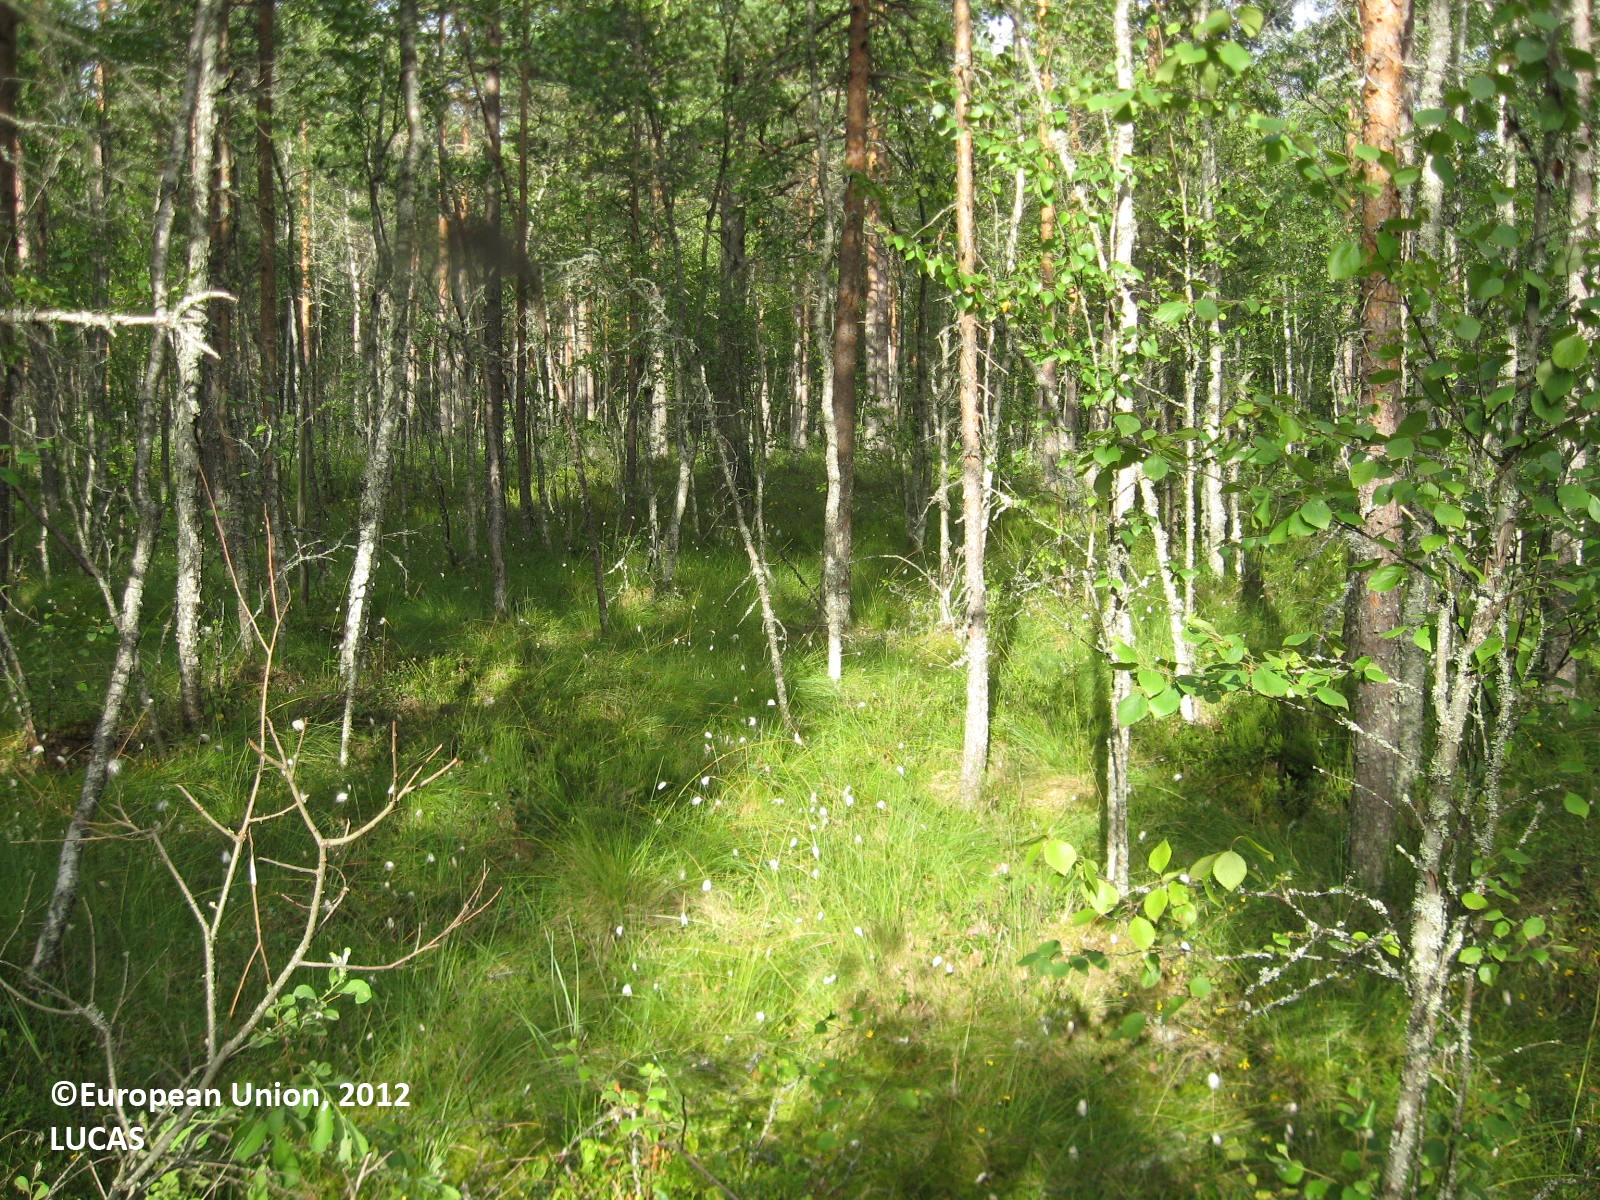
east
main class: Woodland
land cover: Pine dominated mixed woodland
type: boreal forest
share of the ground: > 75 %
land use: Forestry
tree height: > 5 m
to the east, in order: Pine dominated mixed woodland; Ditches and canals; Broadleaved woodland; Tracks; Pine dominated coniferous woodland; Ditches and canals; Pine dominated mixed woodland; Ditches and canals; Pine dominated mixed woodland; Ditches and canals; Pine dominated mixed woodland; Ditches and canals; Pine dominated coniferous woodland; Ditches and canals; Pine dominated coniferous woodland; Ditches and canals; Pine dominated coniferous woodland
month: July
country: FI
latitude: 62.1495
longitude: 22.4338
